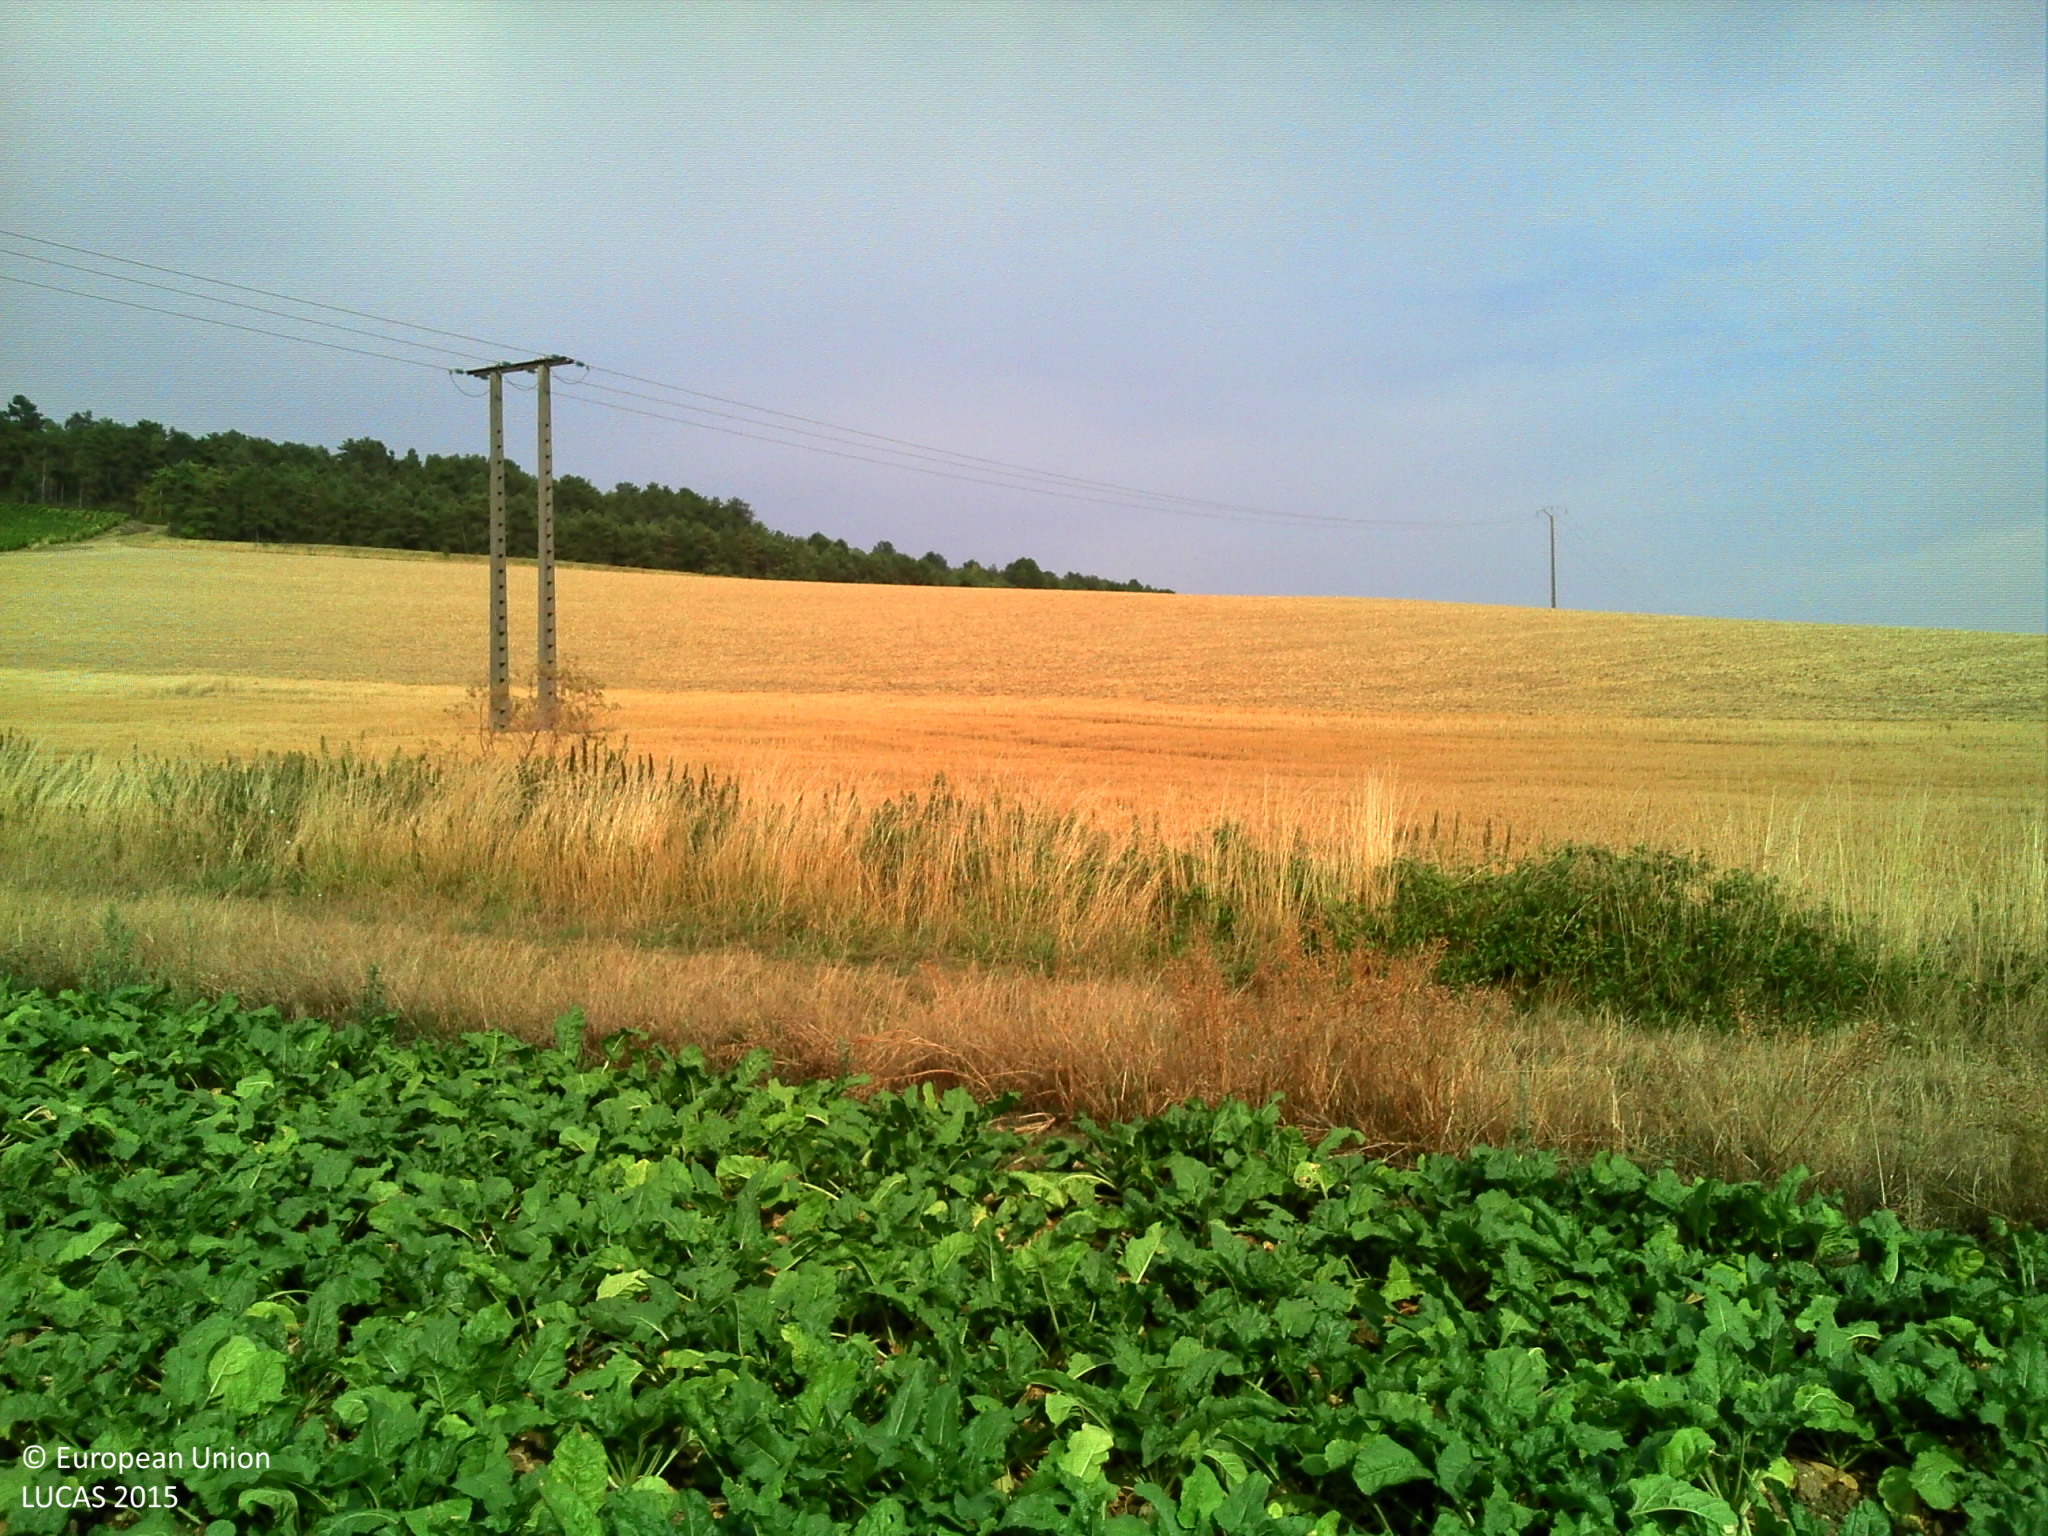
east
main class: Cropland
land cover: Sugar beet
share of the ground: > 75 %
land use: Agriculture (excluding fallow land and kitchen gardens)
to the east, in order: Sugar beet; Grass margins; Tracks; Grass margins; Ditches and canals; Grass margins; Common wheat; Electric lines; Common wheat
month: August
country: FR
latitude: 49.2711
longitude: 3.7129
